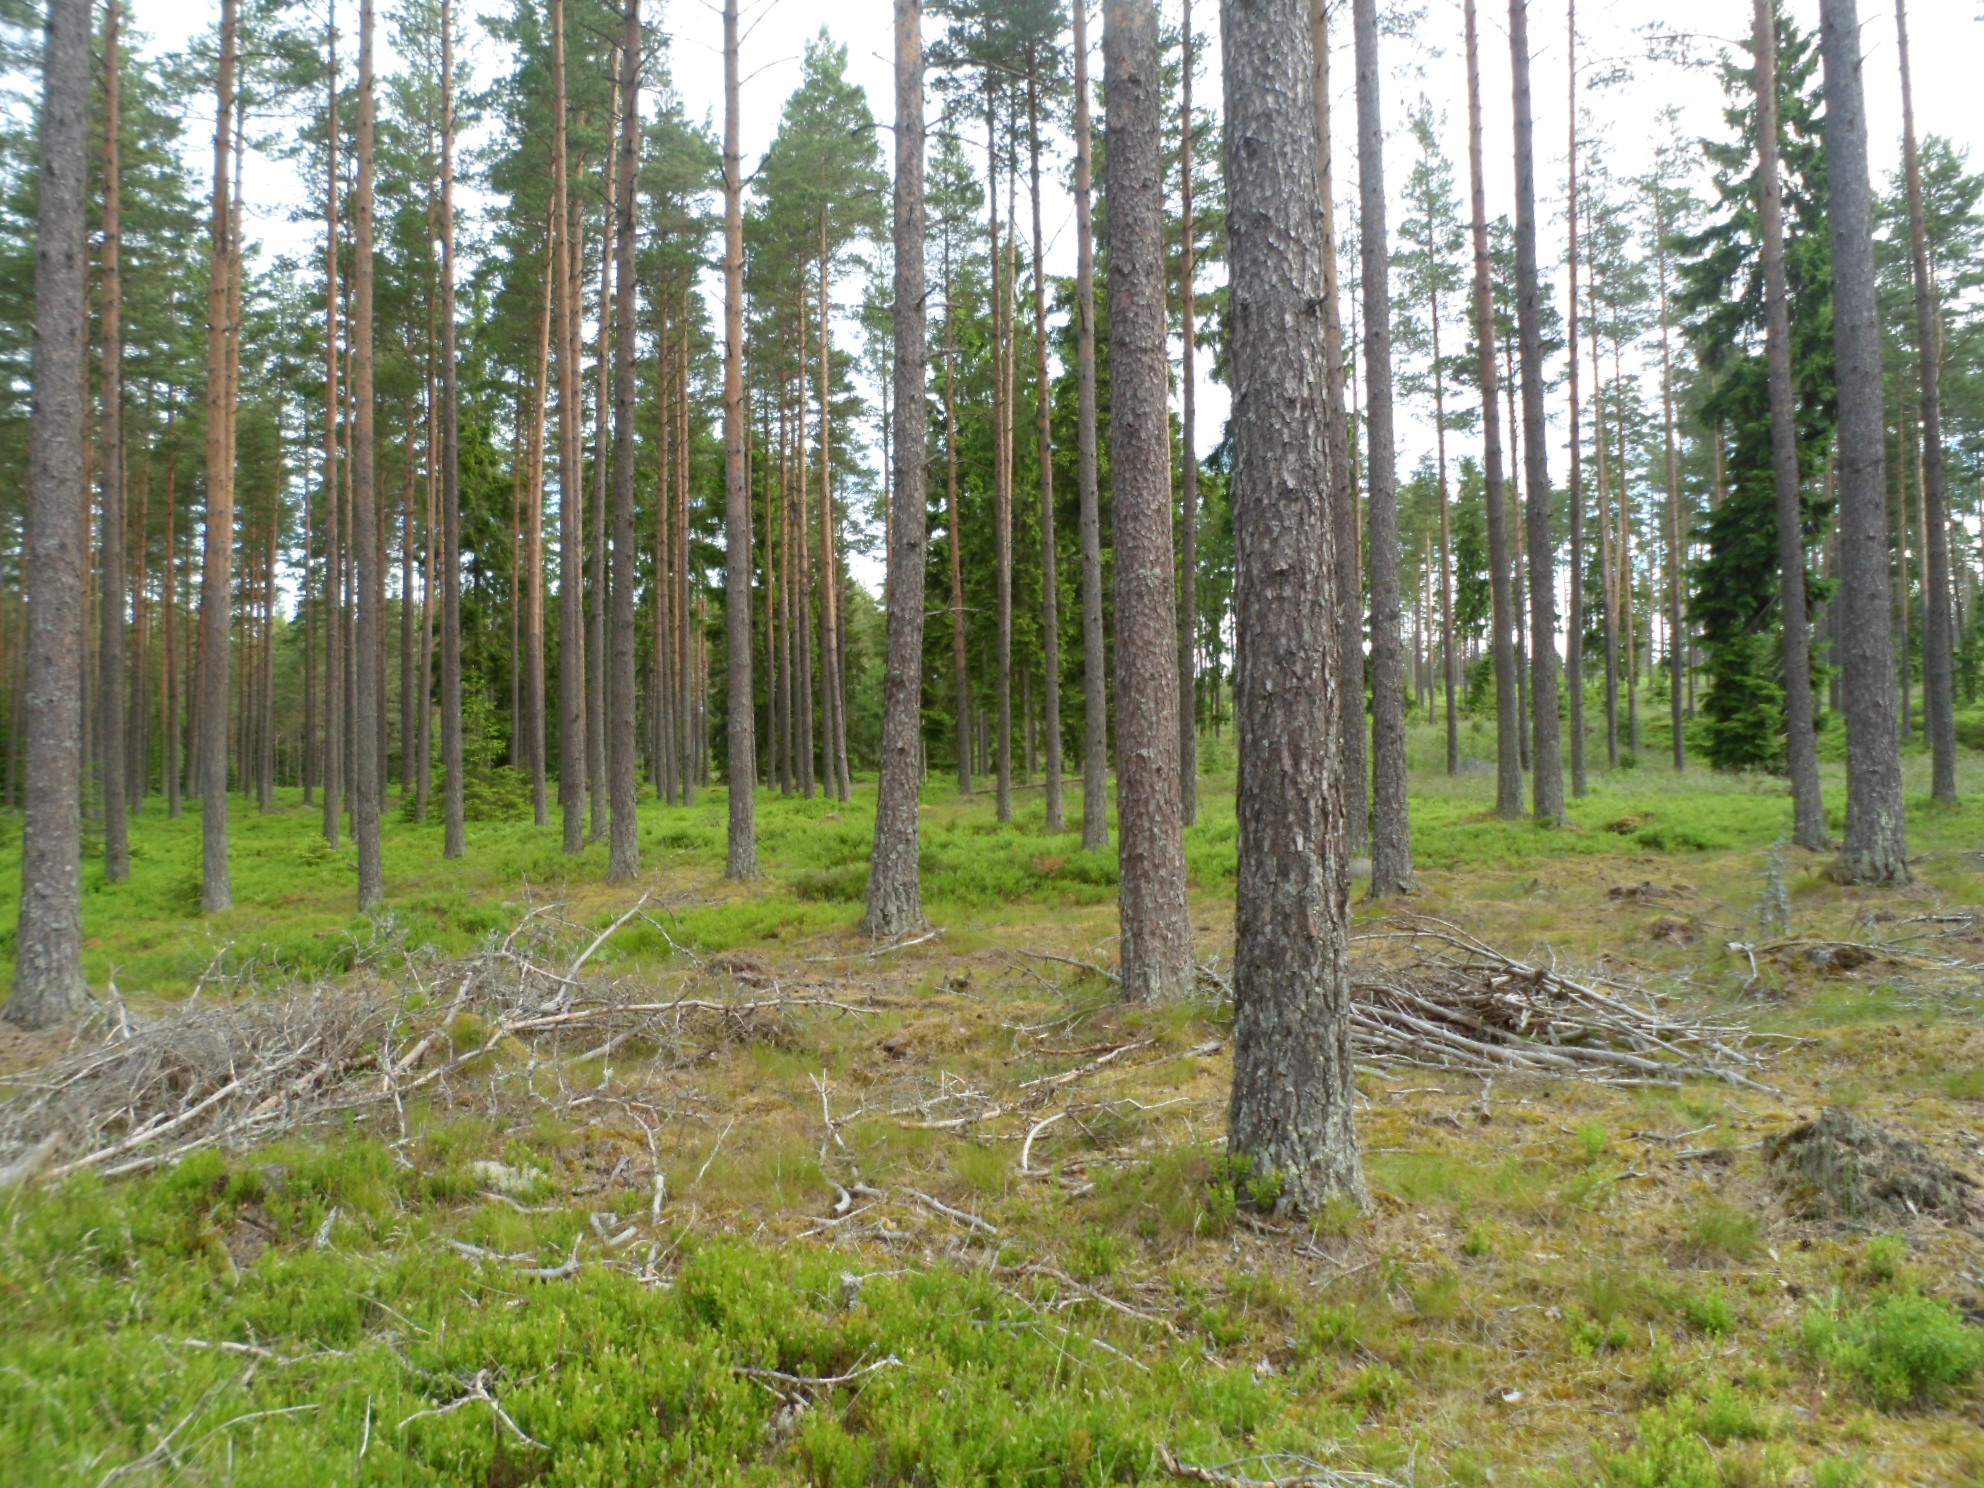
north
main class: Woodland
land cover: Pine dominated coniferous woodland
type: boreal forest
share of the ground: 25 - 50 %
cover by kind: coniferous forest trees 50 %, shrubs 35 %, herbaceous plants 10 %, lichens and mosses 5 %
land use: Forestry
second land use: Amenities, museums, leisure
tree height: > 5 m
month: June
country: SE
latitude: 56.9995
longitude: 15.2490
